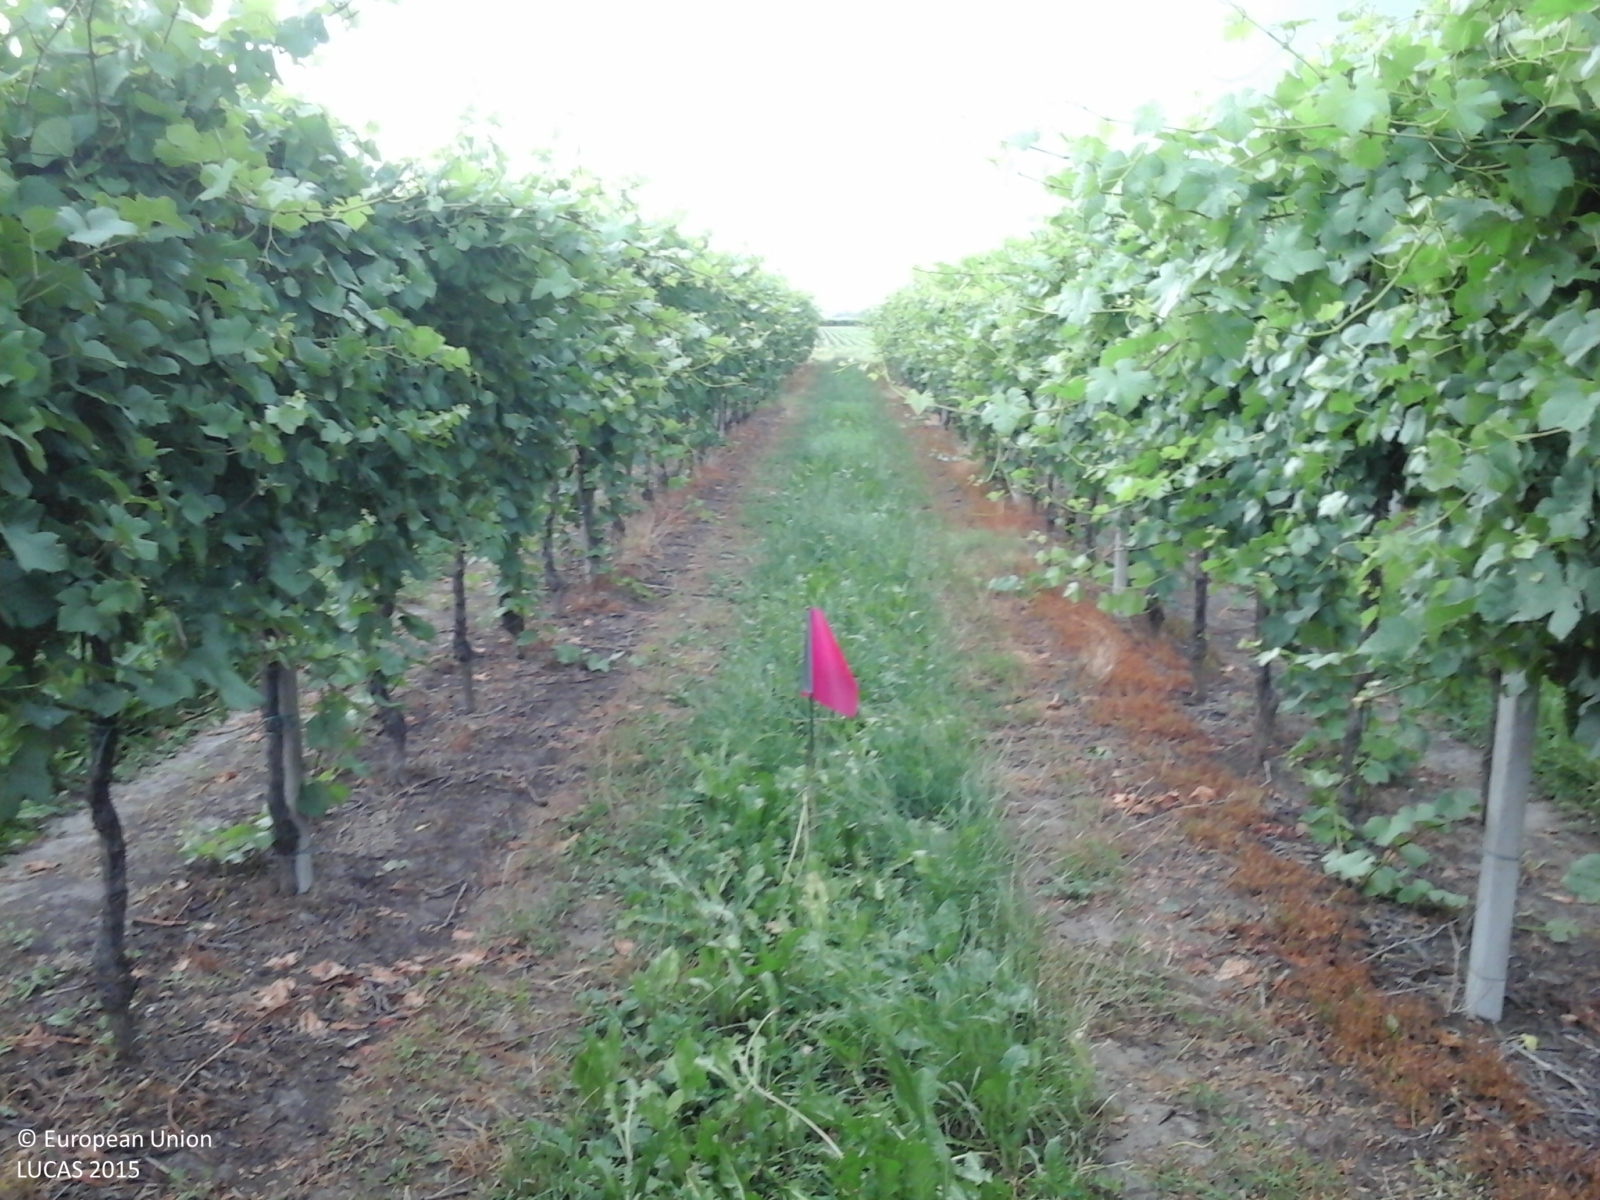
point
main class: Cropland
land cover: Vineyards
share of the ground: 25 - 50 %
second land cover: Grassland without tree/shrub cover
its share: 50 - 75 %
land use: Agriculture (excluding fallow land and kitchen gardens)
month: June
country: IT
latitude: 45.6141
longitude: 12.7019
